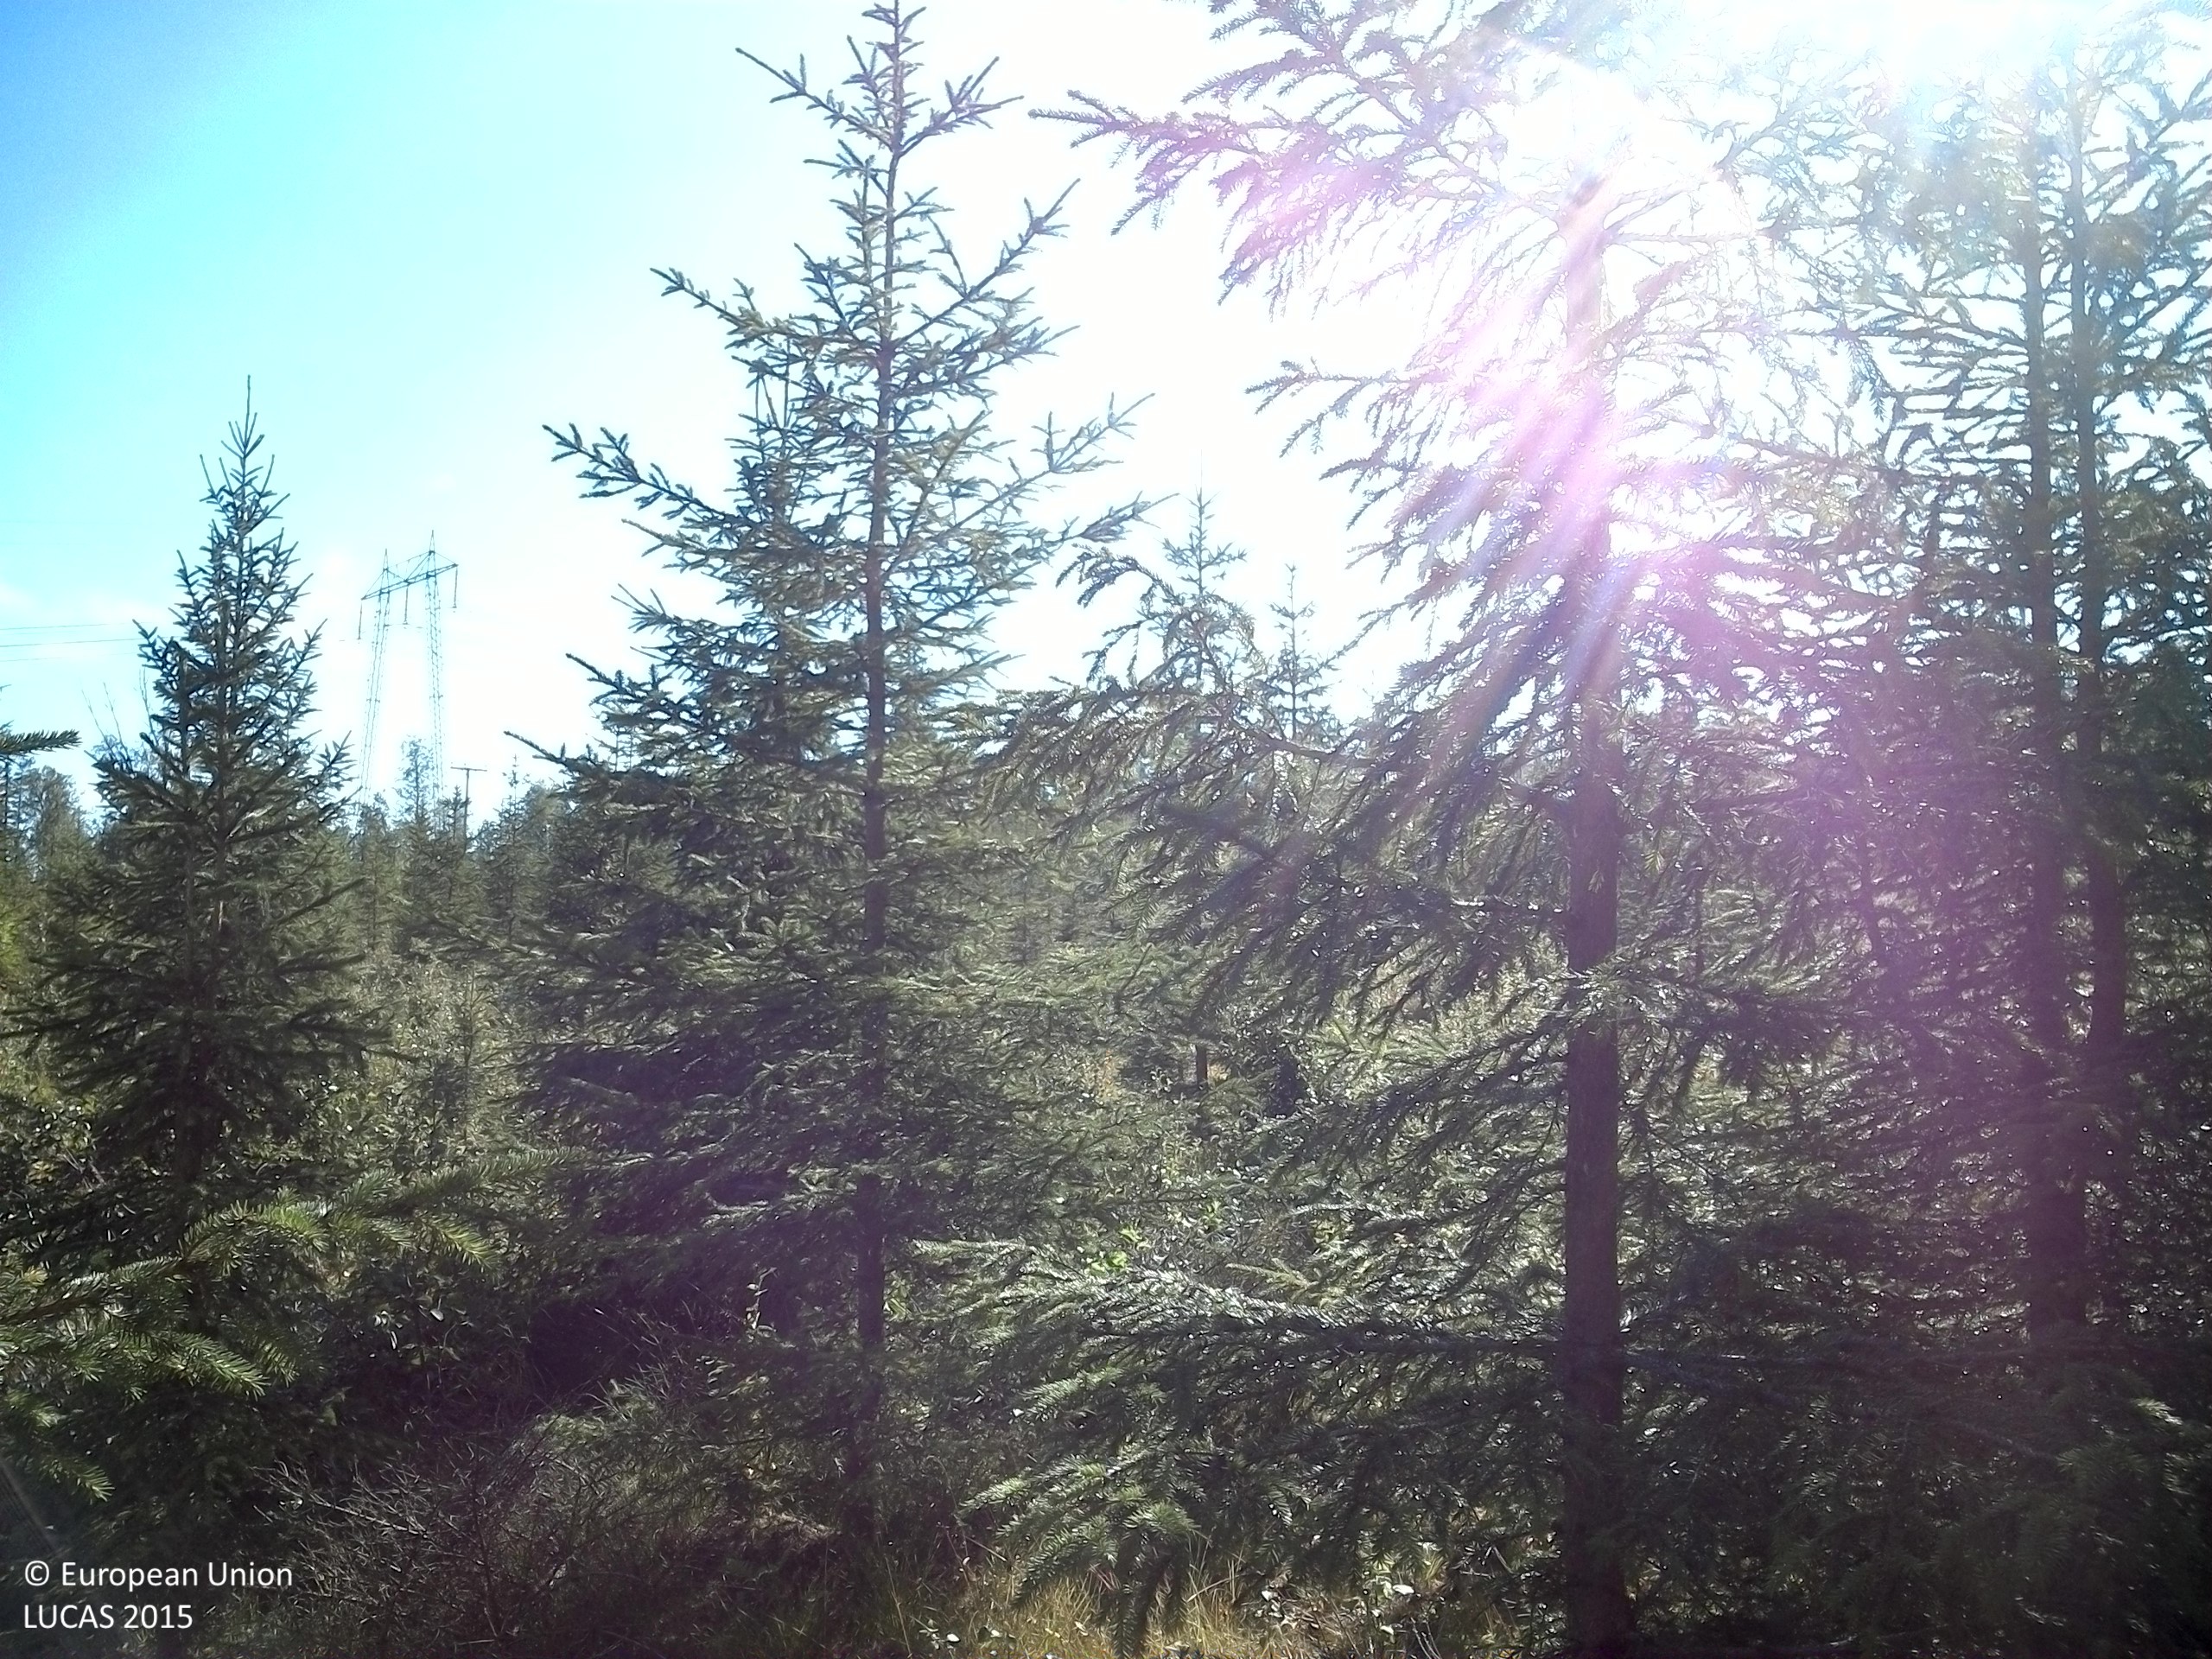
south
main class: Woodland
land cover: Spruce dominated mixed woodland
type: boreal forest
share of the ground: 50 - 75 %
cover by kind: coniferous forest trees 50 %, broadleaved forest trees 20 %, shrubs 10 %, herbaceous plants 10 %, lichens and mosses 10 %
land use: Forestry
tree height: < 5 m
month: August
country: SE
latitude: 63.8051
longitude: 17.4643
